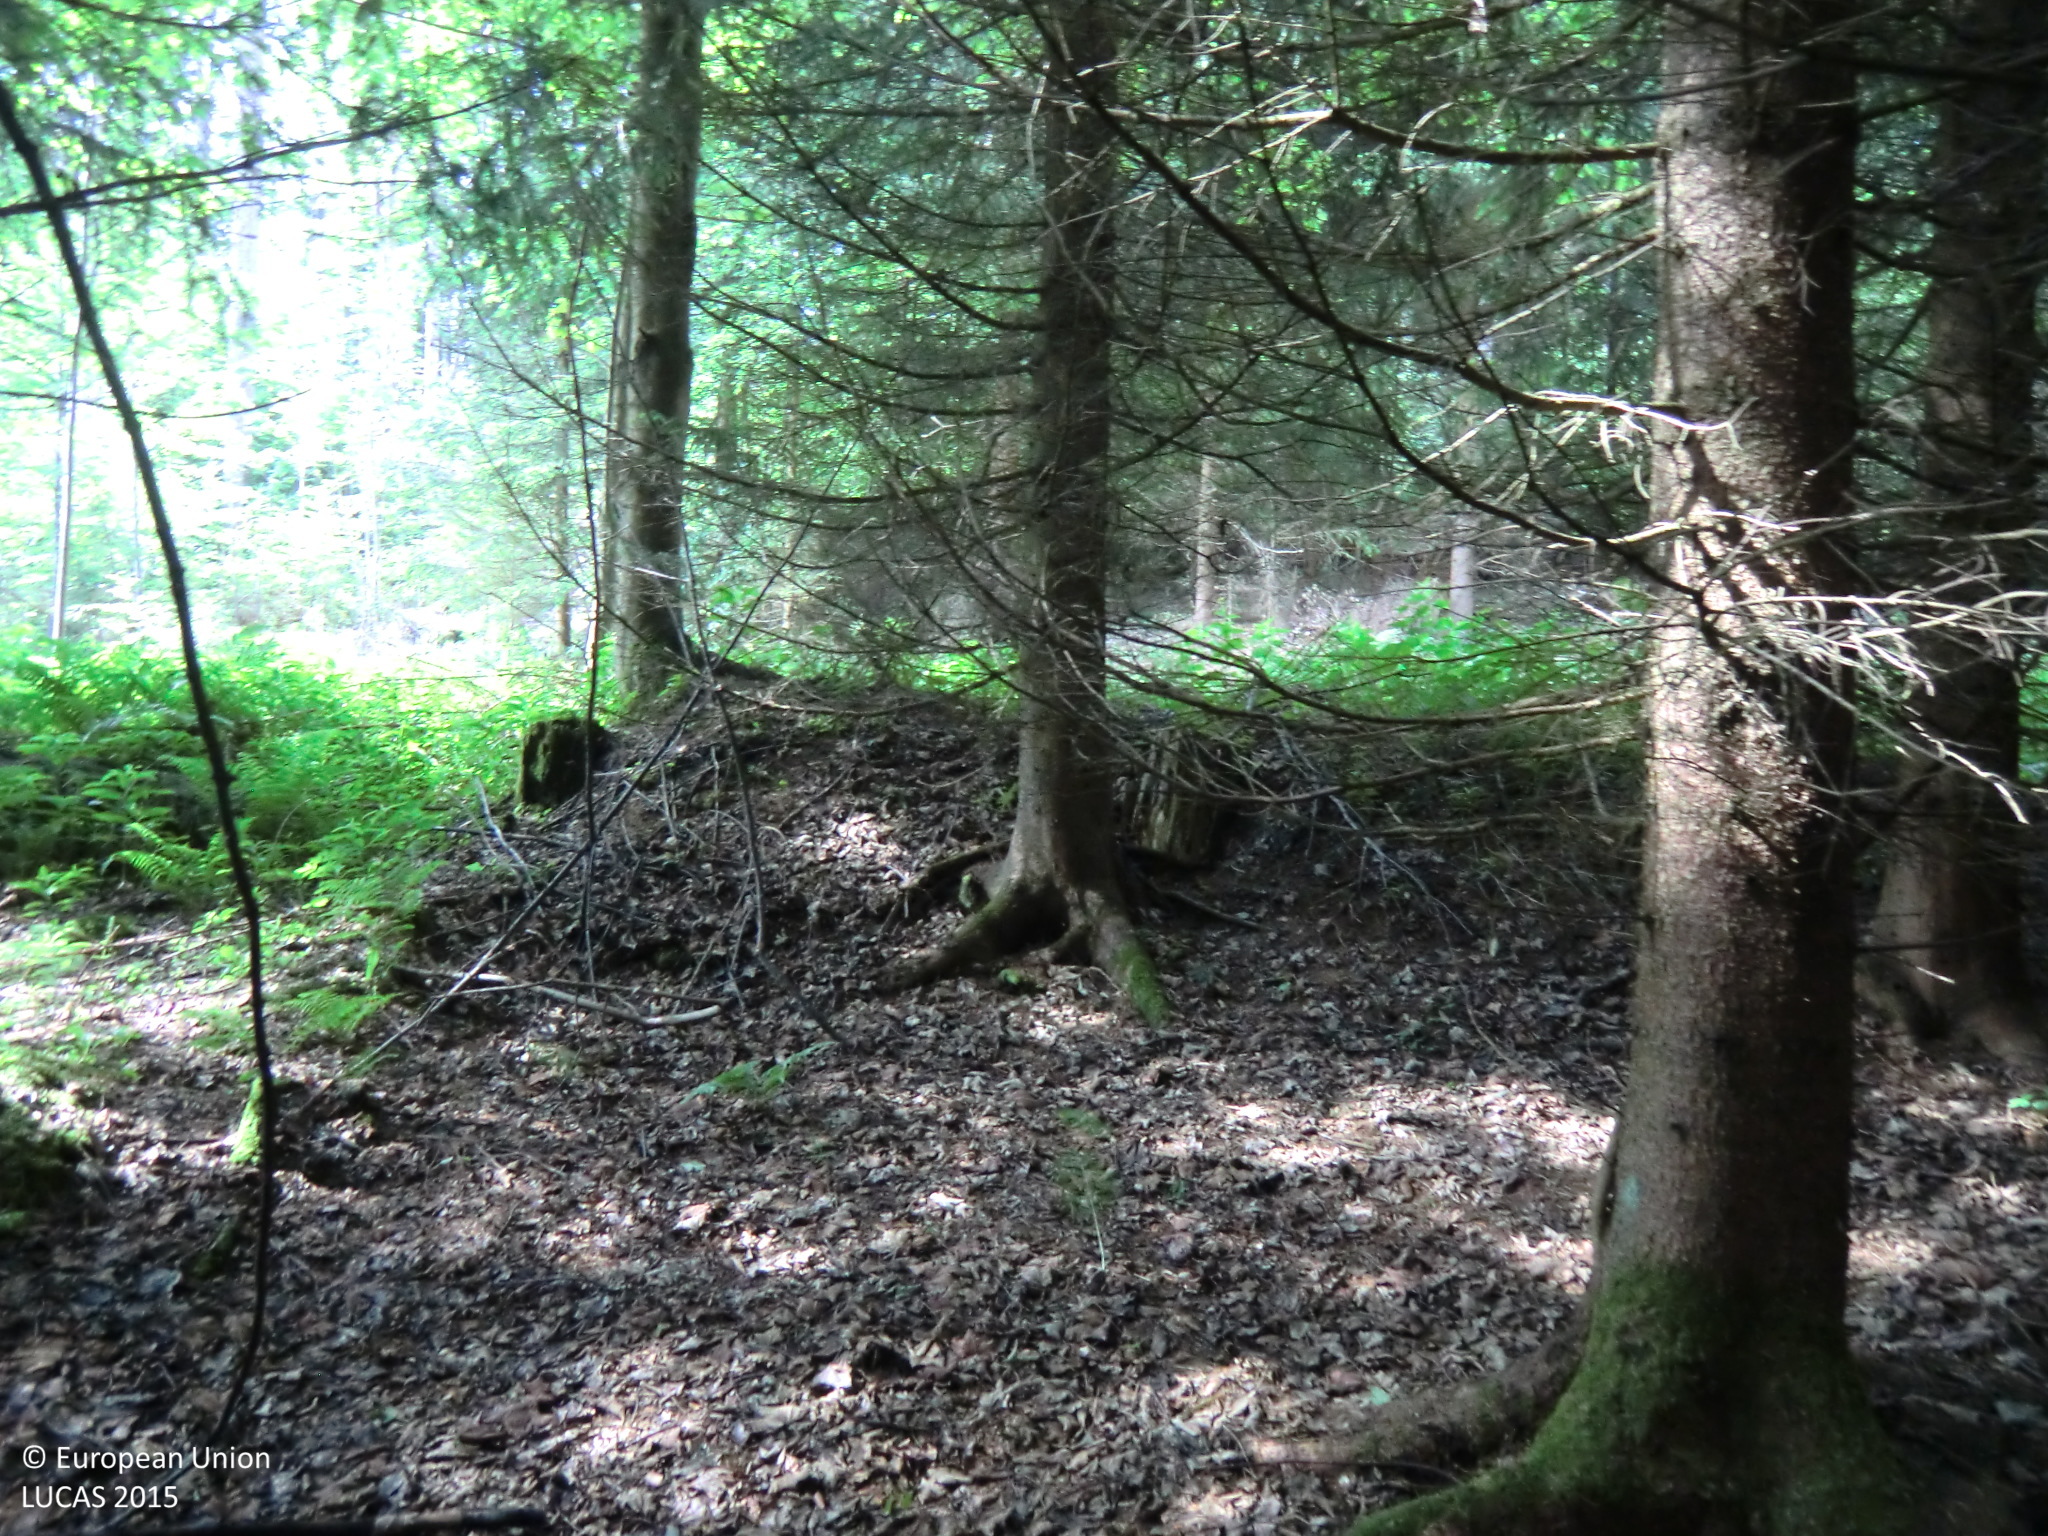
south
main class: Woodland
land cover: Spruce dominated coniferous woodland
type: hemiboreal forest and nemoral coniferous forest and mixed broadleaved-coniferous forest
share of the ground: > 75 %
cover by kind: coniferous forest trees 90 %, broadleaved forest trees 10 %
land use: Forestry
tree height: > 5 m
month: June
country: AT
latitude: 48.4770
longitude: 14.8577
